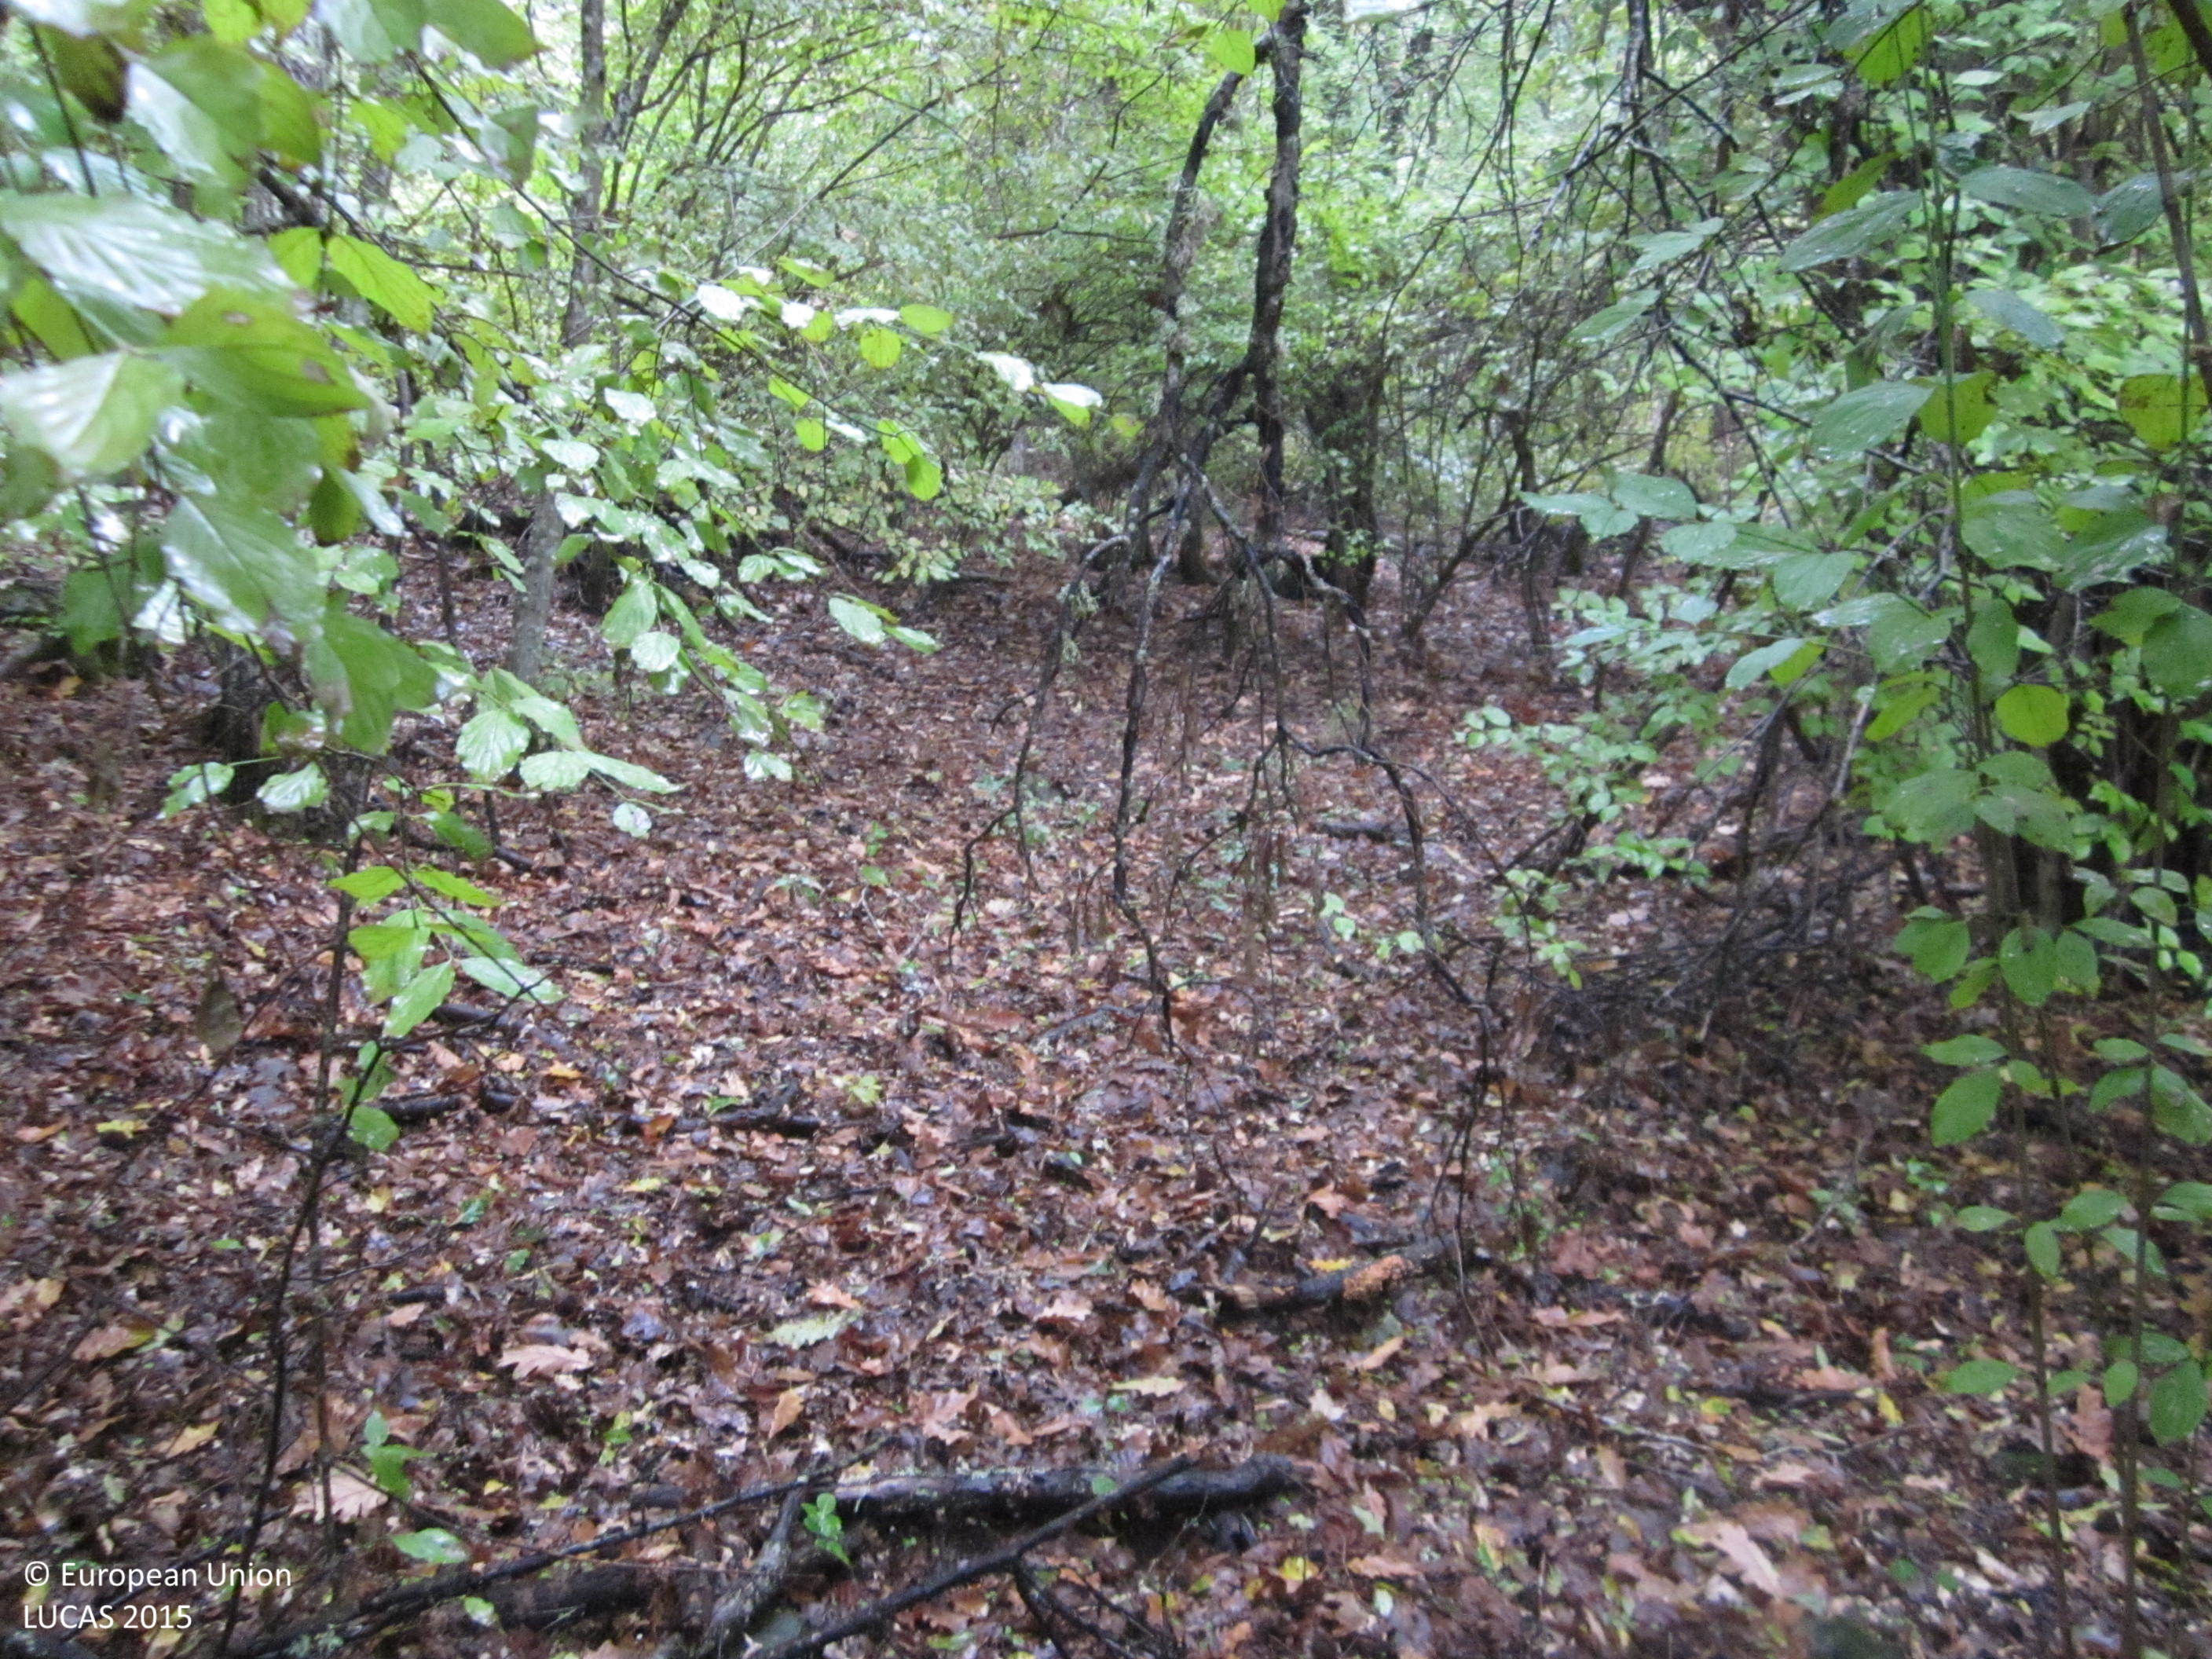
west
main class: Woodland
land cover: Broadleaved woodland
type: mesophytic deciduous forest
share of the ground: > 75 %
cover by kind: broadleaved forest trees 100 %
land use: Forestry
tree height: > 5 m
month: October
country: BG
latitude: 42.1414
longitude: 27.2265
